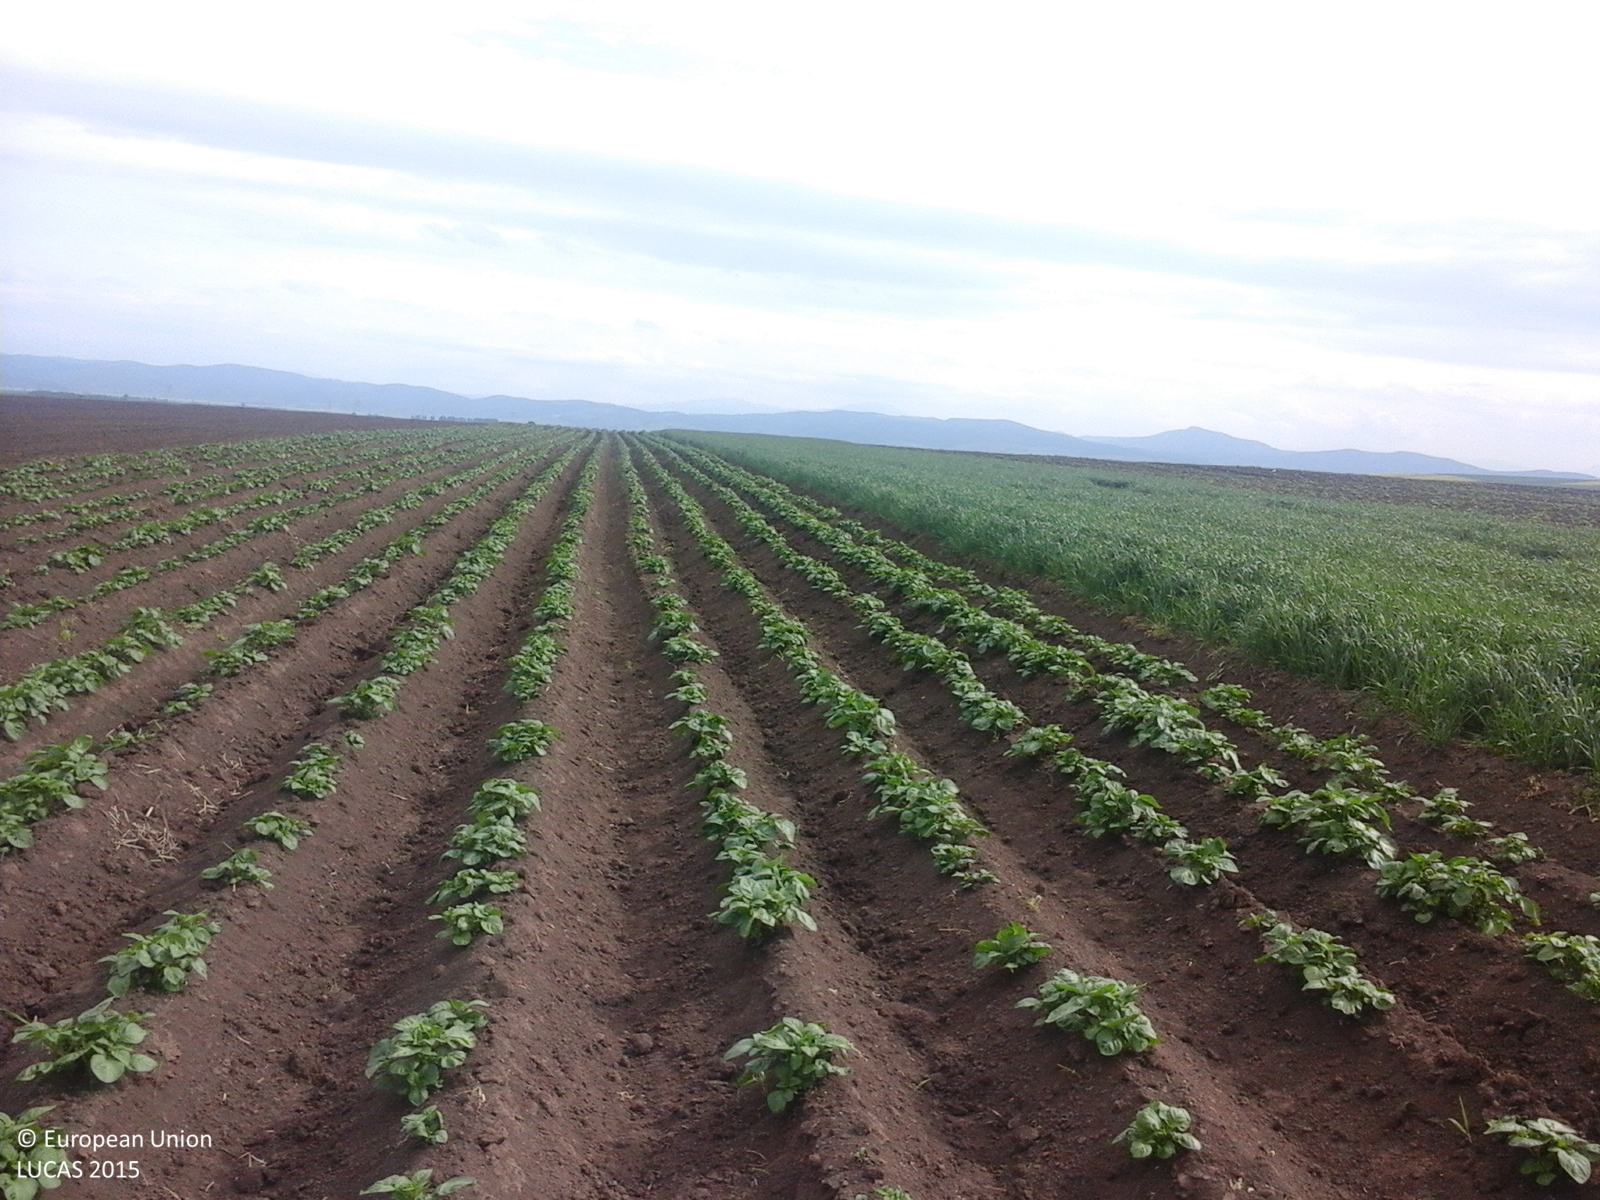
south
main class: Cropland
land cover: Potatoes
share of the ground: 10 - 25 %
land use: Agriculture (excluding fallow land and kitchen gardens)
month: May
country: RO
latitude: 45.9195
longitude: 26.0412
